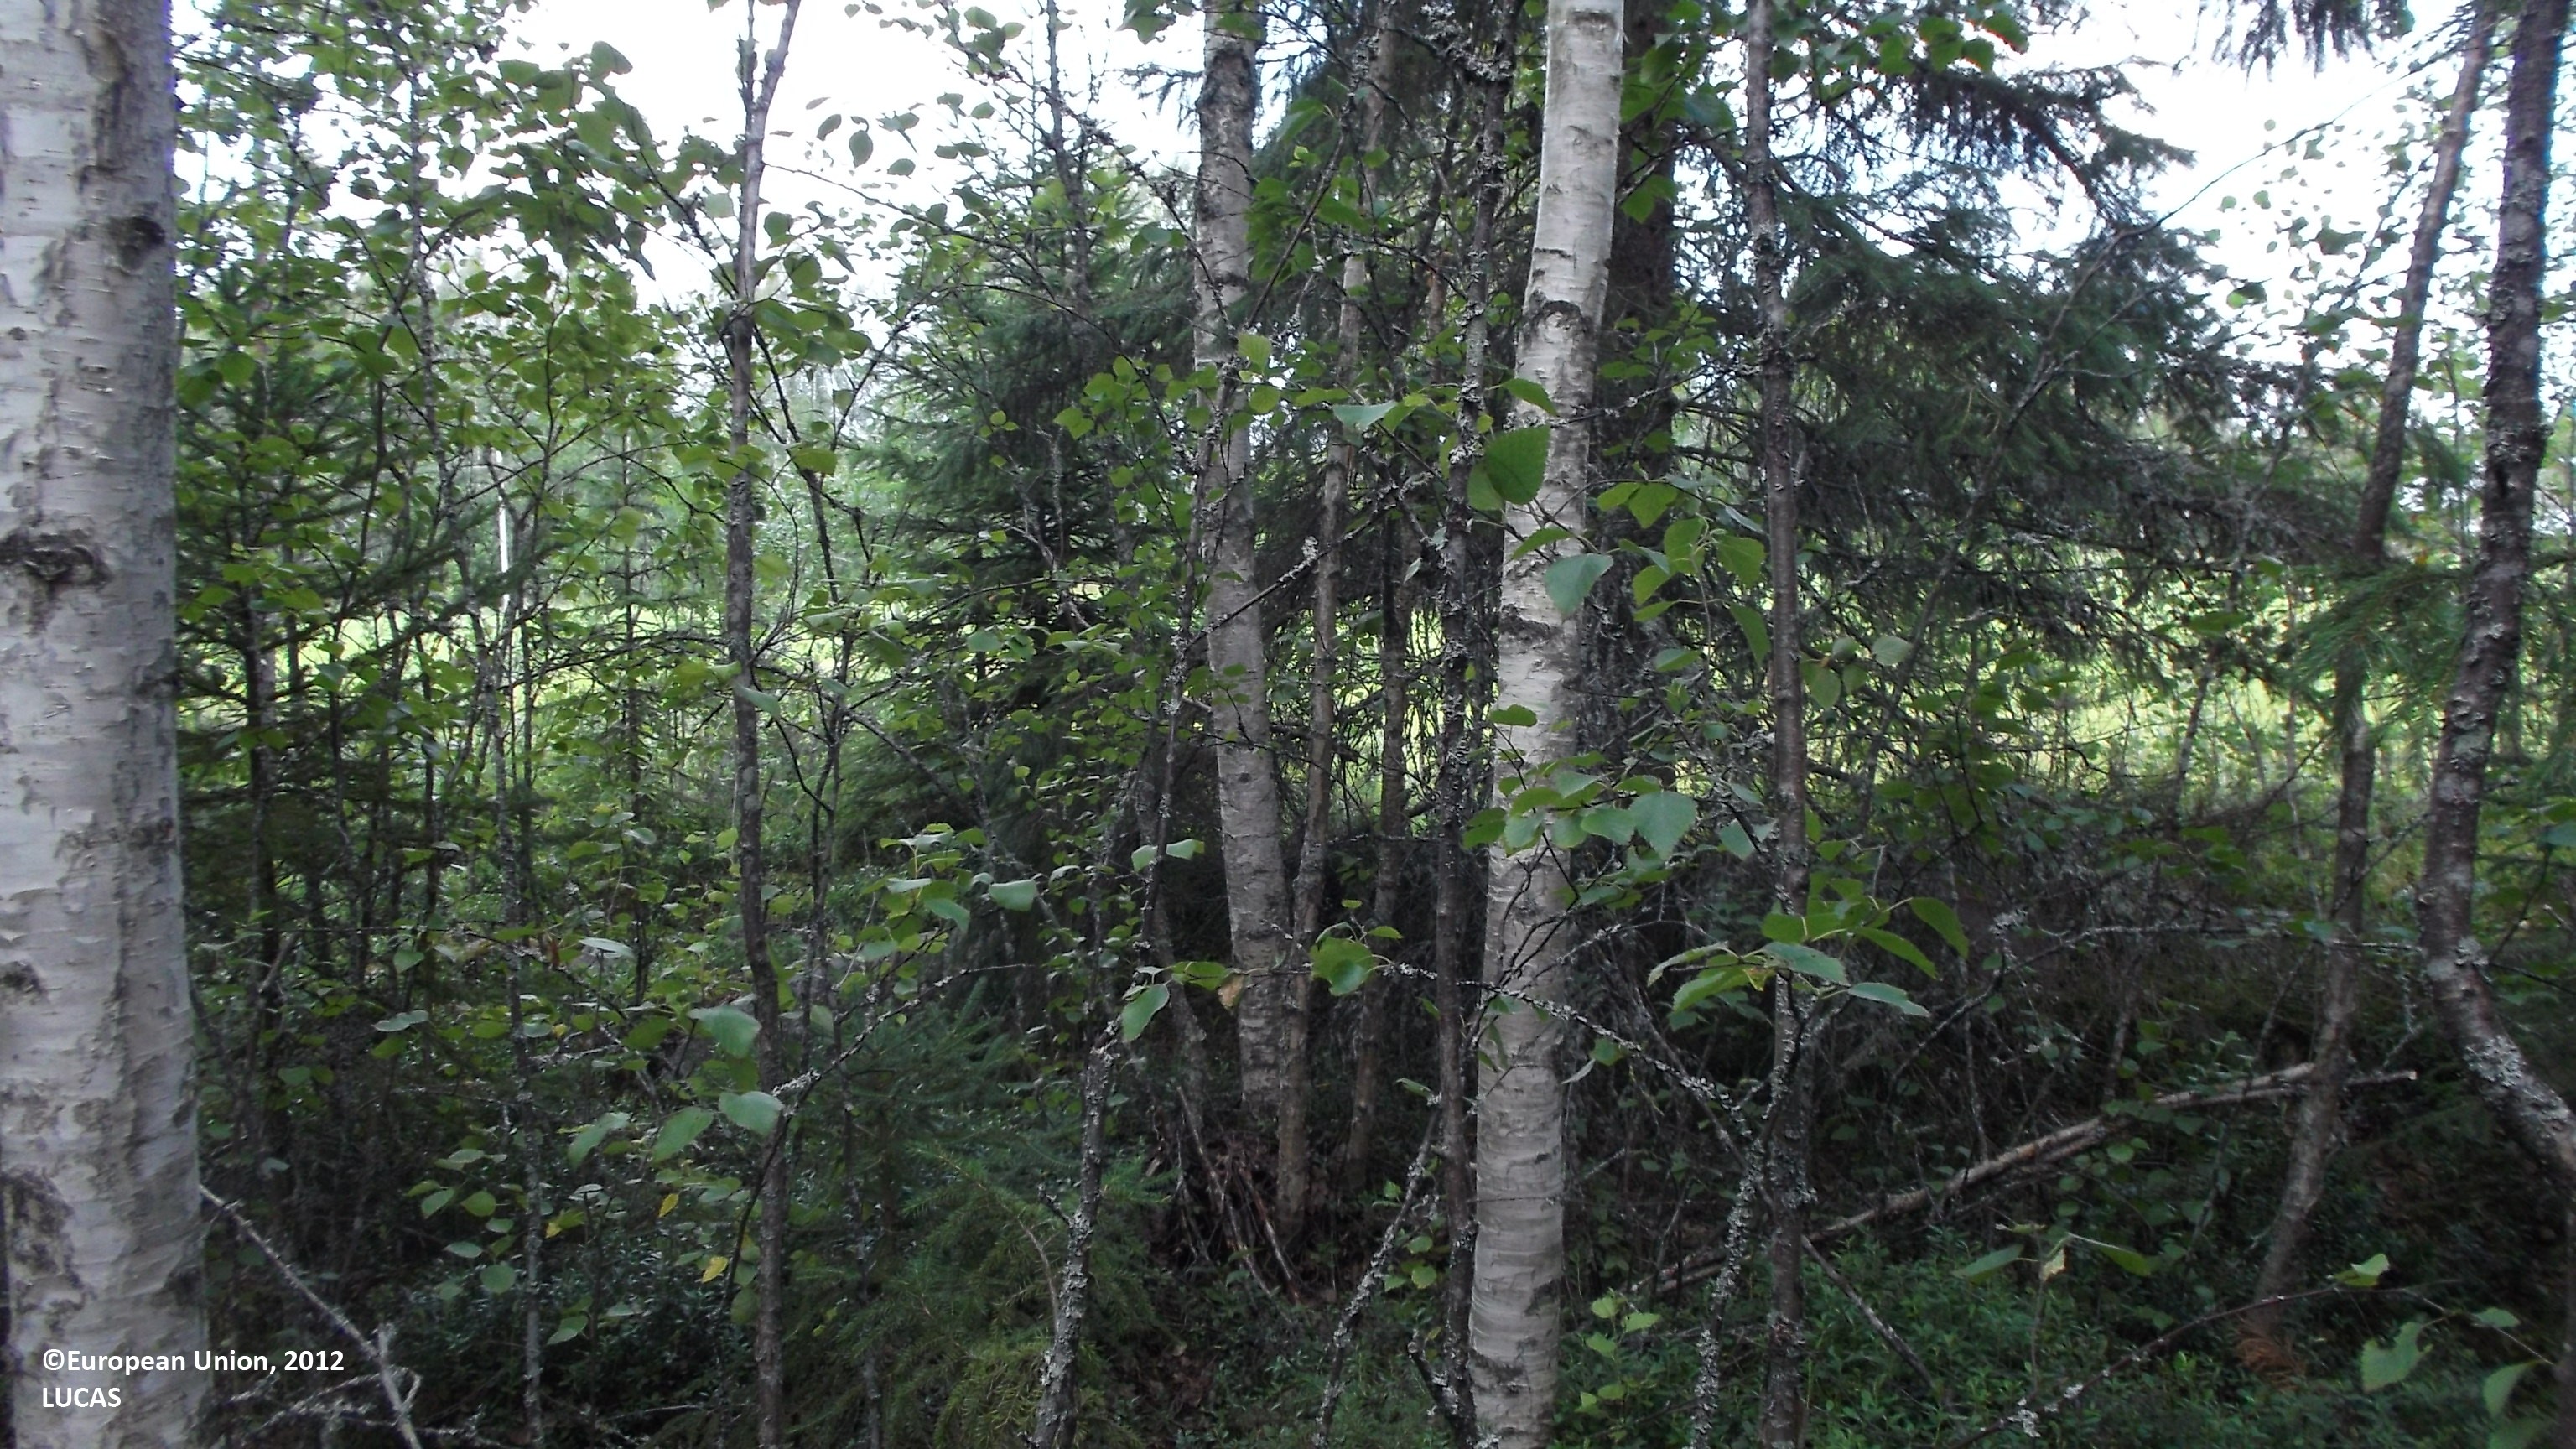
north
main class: Woodland
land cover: Spruce dominated mixed woodland
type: boreal forest
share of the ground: > 75 %
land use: Forestry
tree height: > 5 m
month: July
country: FI
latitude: 63.5915
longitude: 22.9296
